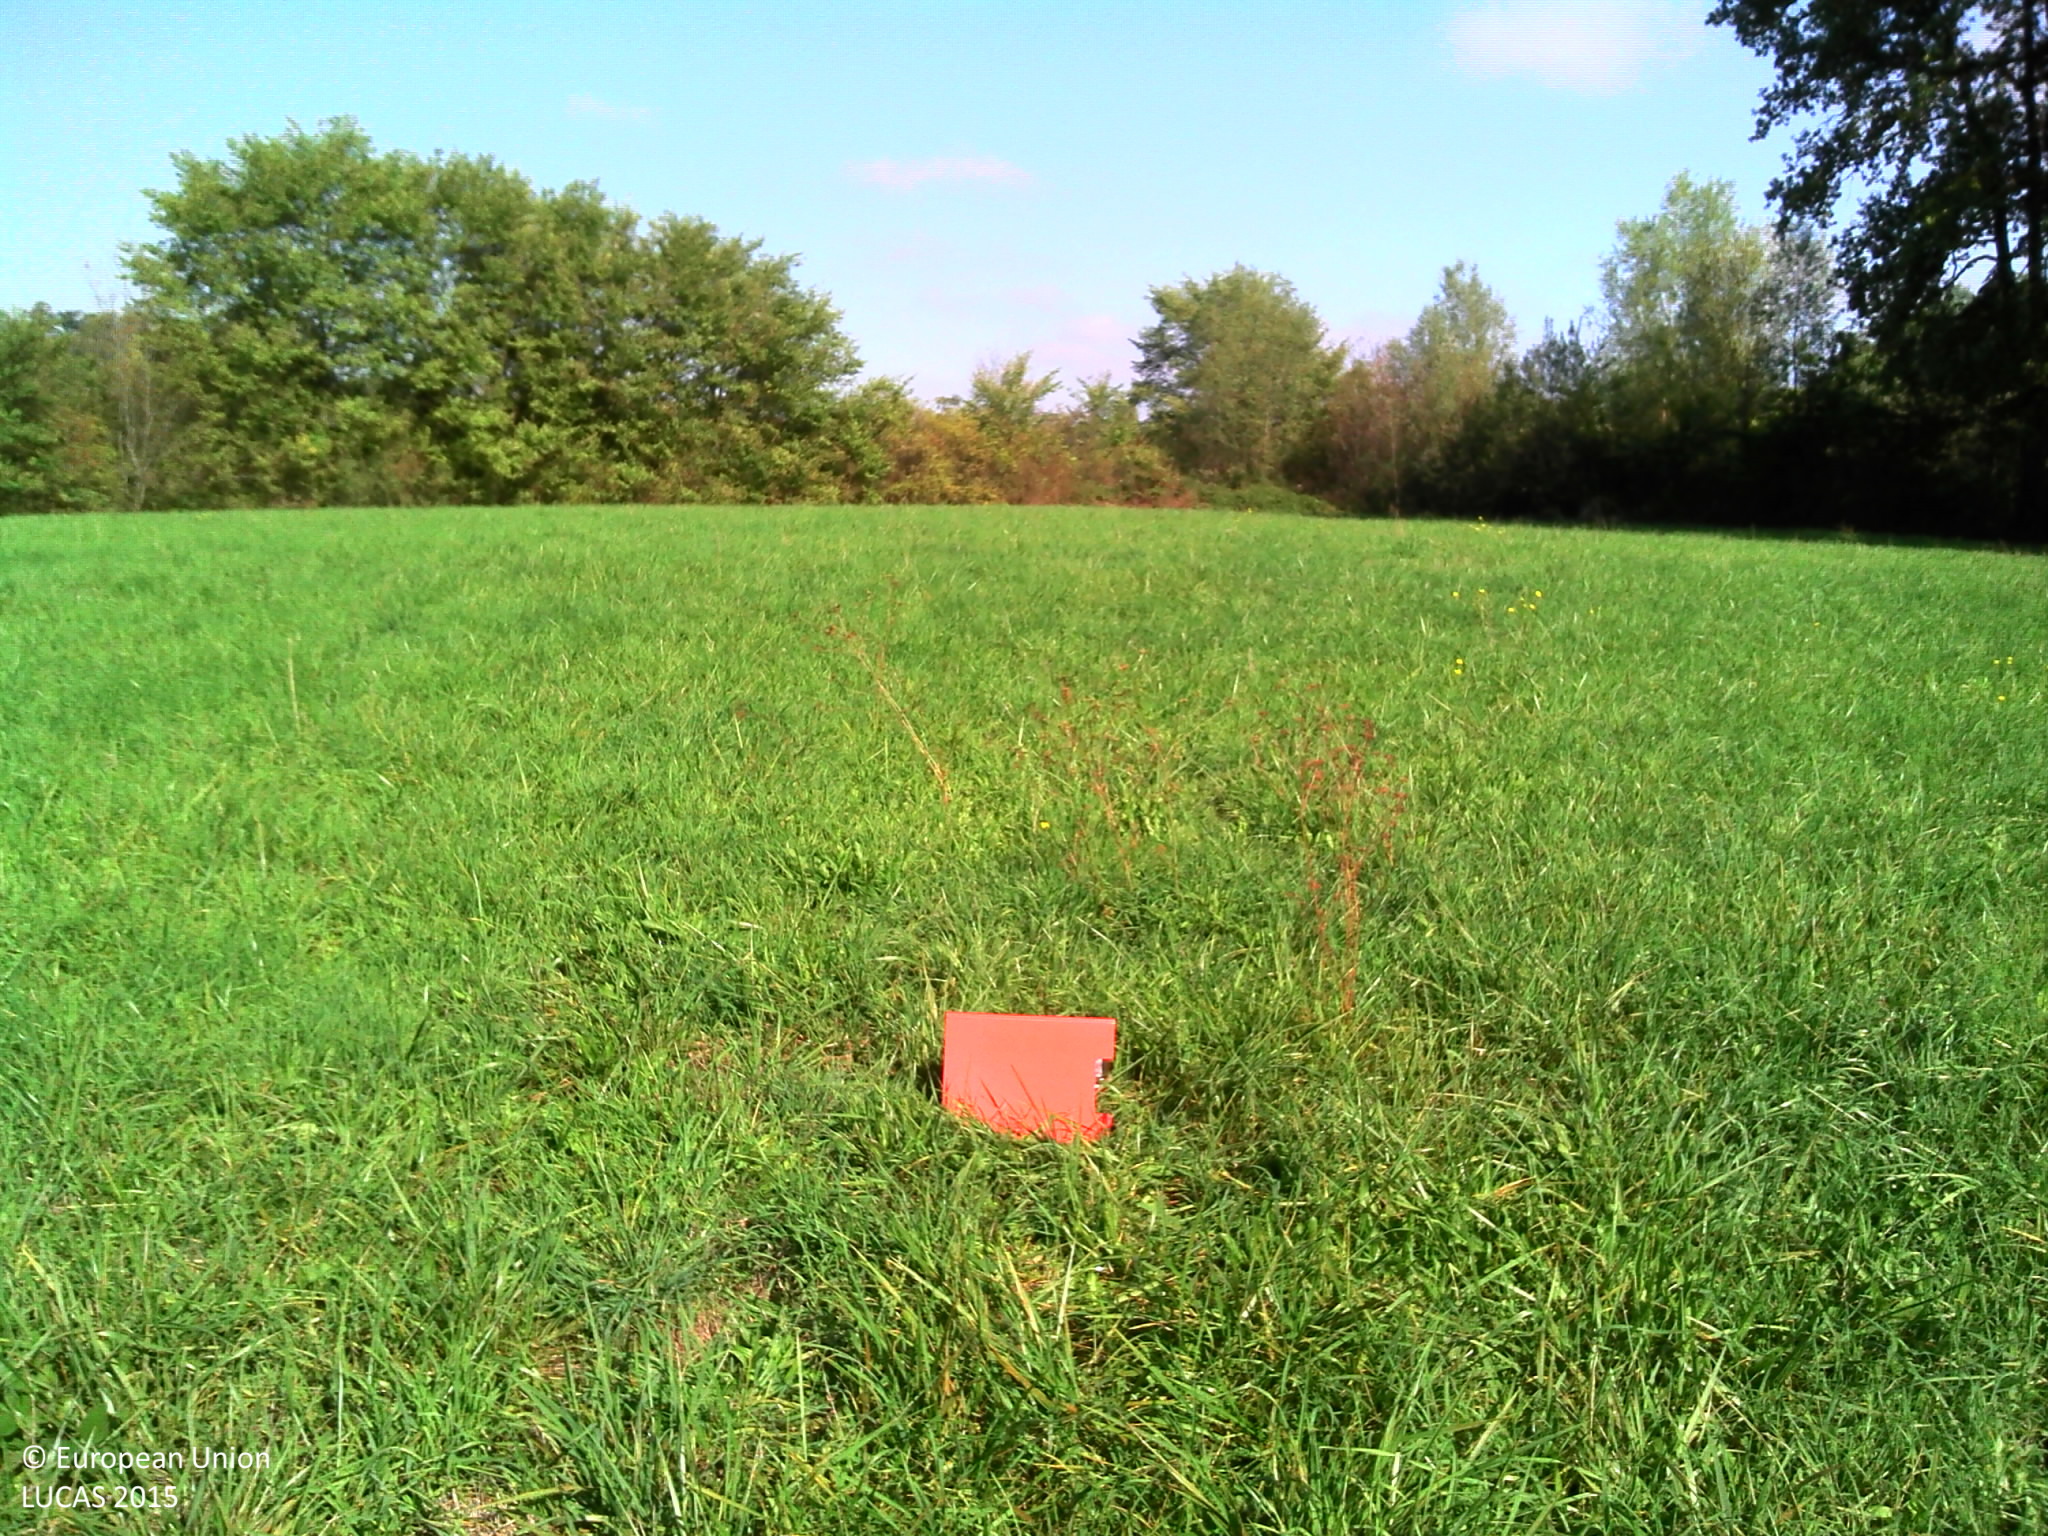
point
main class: Grassland
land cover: Grassland without tree/shrub cover
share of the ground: > 75 %
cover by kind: herbaceous plants 100 %
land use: Agriculture (excluding fallow land and kitchen gardens)
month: October
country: FR
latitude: 46.2838
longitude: 4.9017
